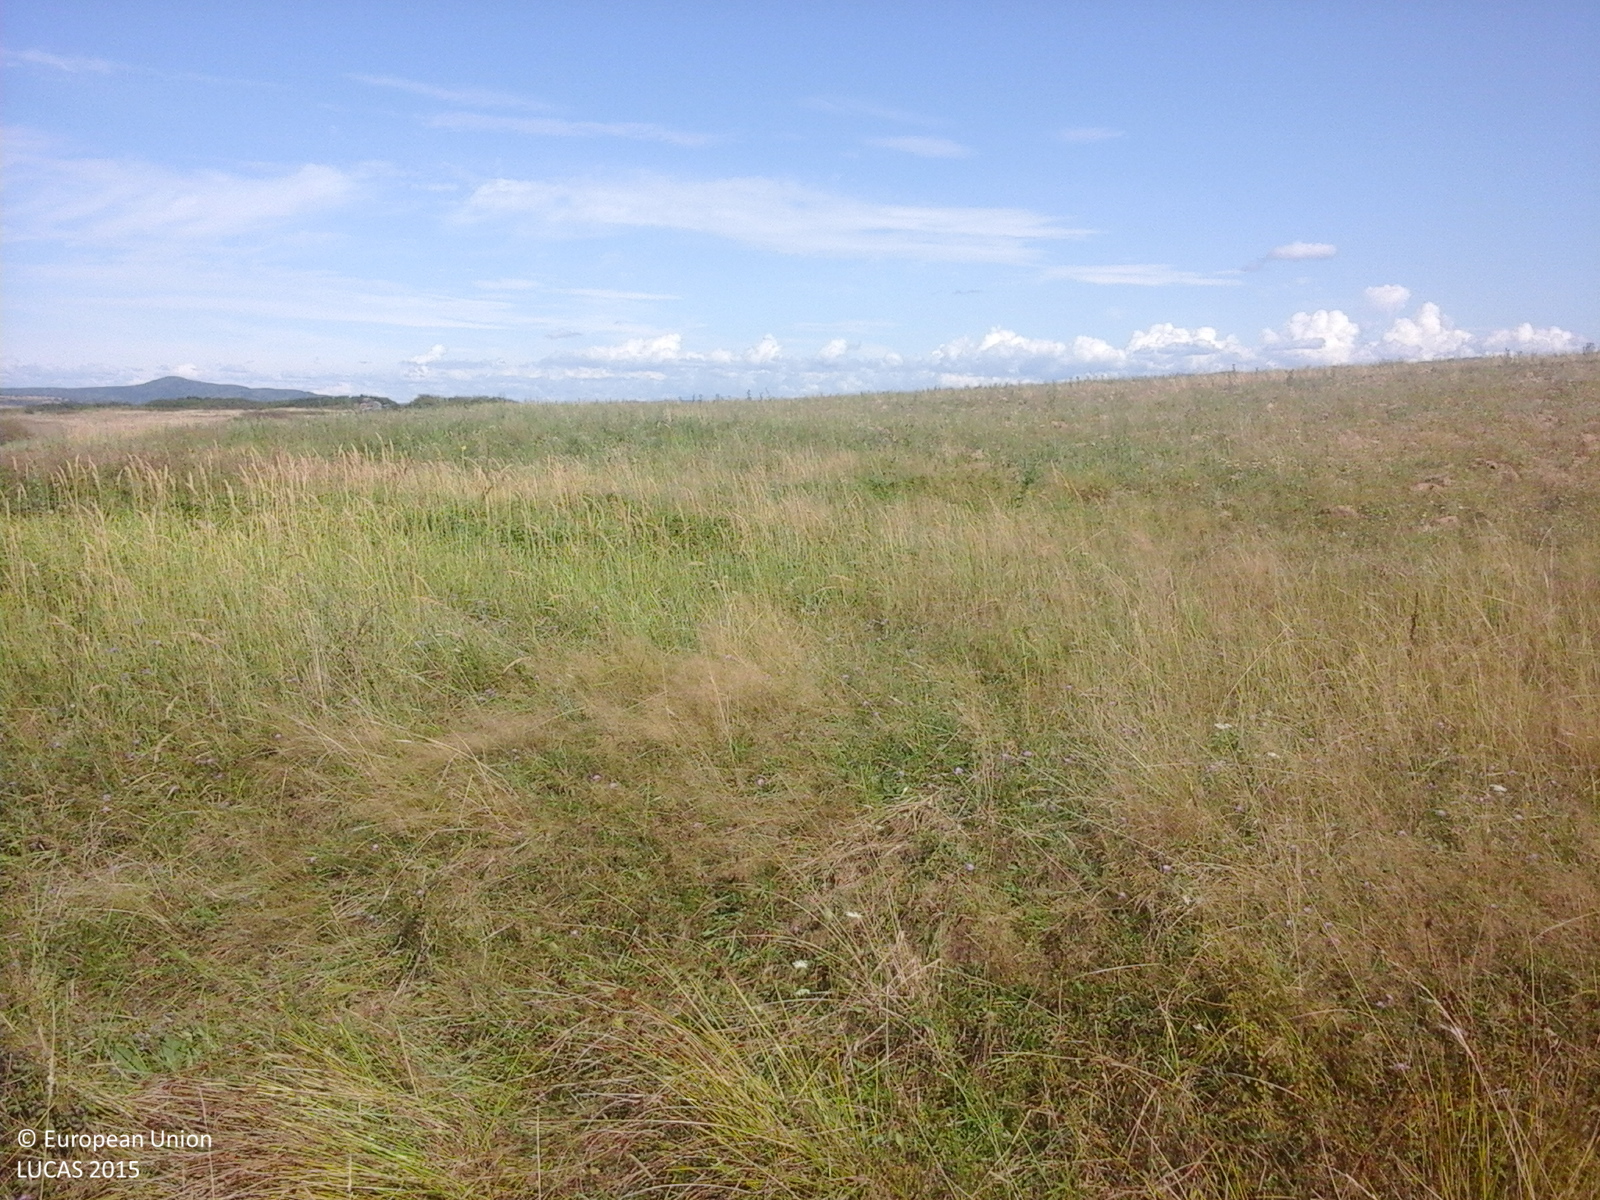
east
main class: Grassland
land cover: Grassland with sparse tree/shrub cover
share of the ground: > 75 %
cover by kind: herbaceous plants 90 %, broadleaved forest trees 5 %, shrubs 5 %
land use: Agriculture (excluding fallow land and kitchen gardens)
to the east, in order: Grassland with sparse tree/shrub cover; Ditches and canals; Grassland with sparse tree/shrub cover; Spontaneously vegetated surfaces; Grassland with sparse tree/shrub cover; Ditches and canals; Grassland with sparse tree/shrub cover
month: August
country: RO
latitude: 45.3678
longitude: 21.6391
